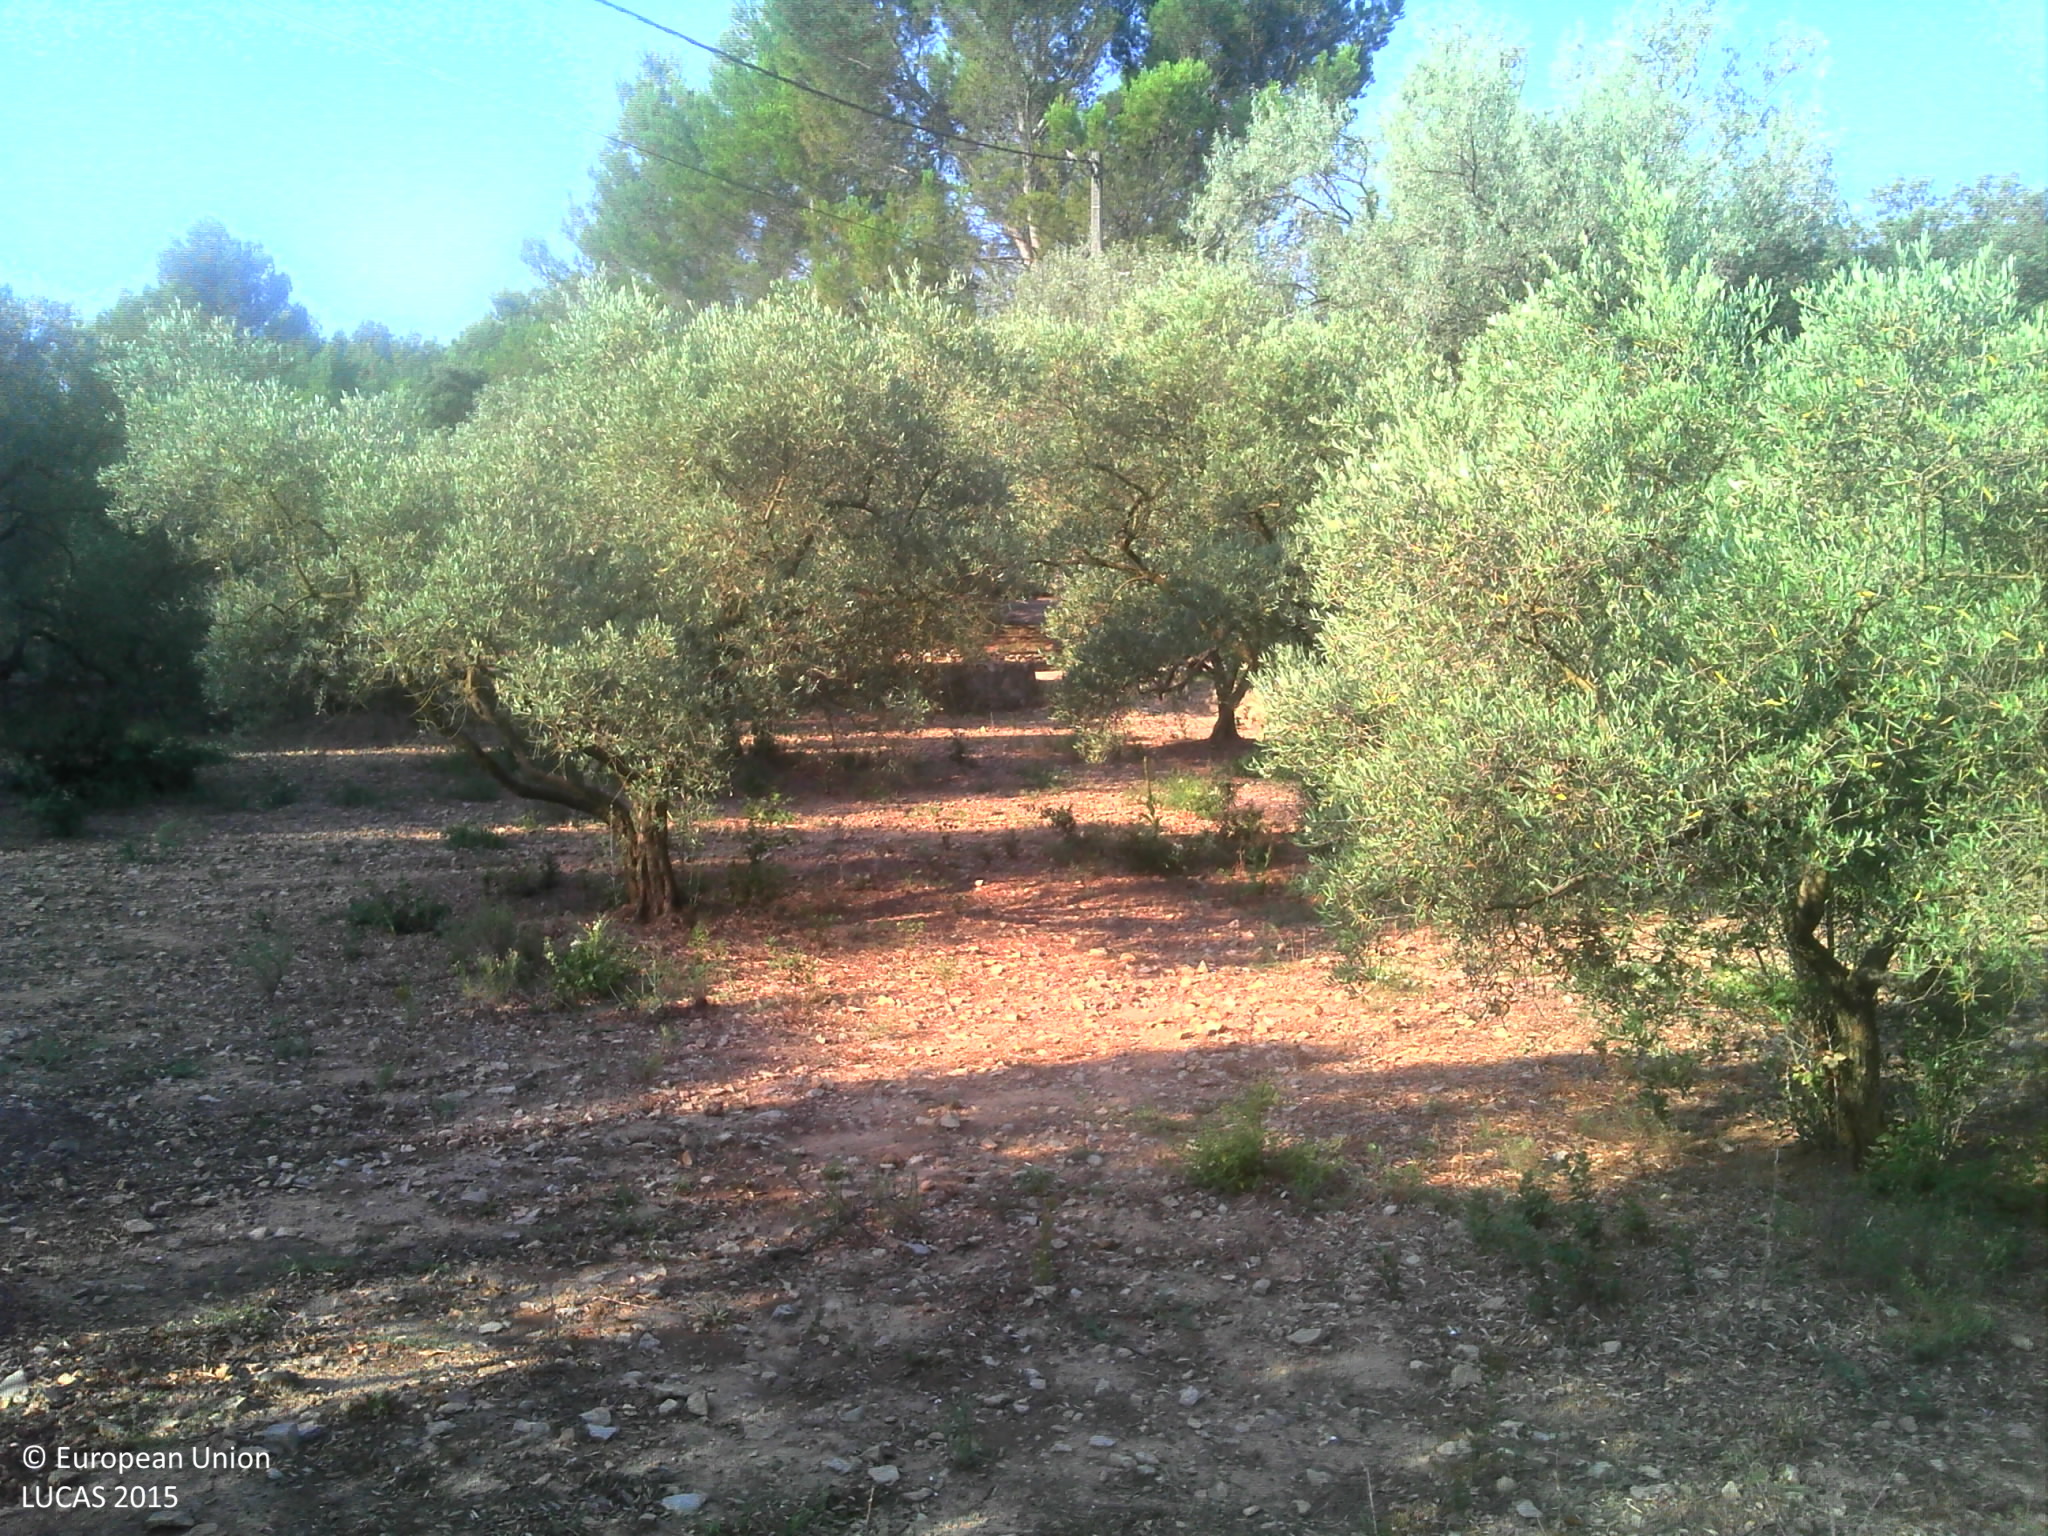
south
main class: Cropland
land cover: Olive groves
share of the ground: 10 - 25 %
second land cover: Other bare soil
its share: > 75 %
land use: Agriculture (excluding fallow land and kitchen gardens)
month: July
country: FR
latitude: 43.6043
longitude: 5.1408
